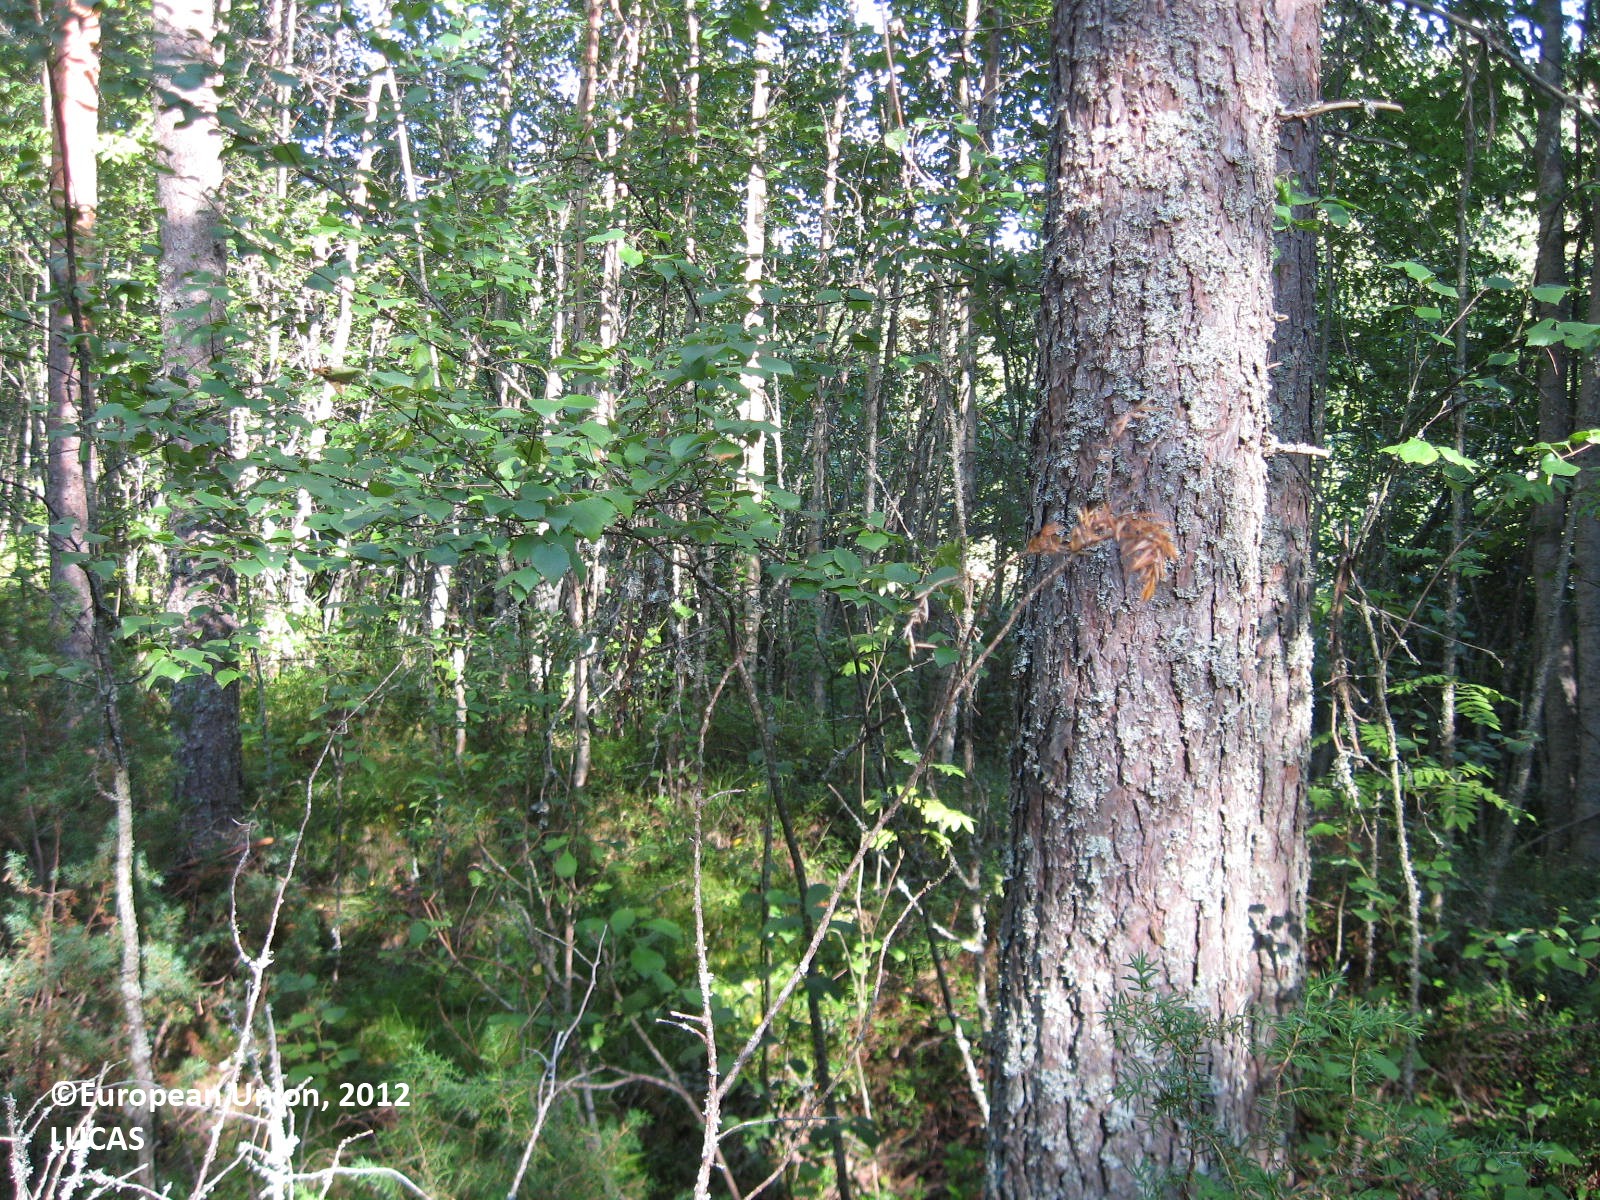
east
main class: Woodland
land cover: Pine dominated mixed woodland
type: boreal forest
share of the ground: > 75 %
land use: Forestry
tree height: > 5 m
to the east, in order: Pine dominated mixed woodland; Ditches and canals; Broadleaved woodland; Grassland without tree/shrub cover; Abandoned hedges; Ditches and canals; Abandoned hedges; Grassland without tree/shrub cover; Abandoned hedges; Ditches and canals; Abandoned hedges; Grassland without tree/shrub cover; Broadleaved woodland; Ditches and canals; Pine dominated mixed woodland; Grassland with sparse tree/shrub cover; Electric lines; Grassland with sparse tree/shrub cover; Pine dominated mixed woodland
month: July
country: FI
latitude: 61.9504
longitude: 22.6242
